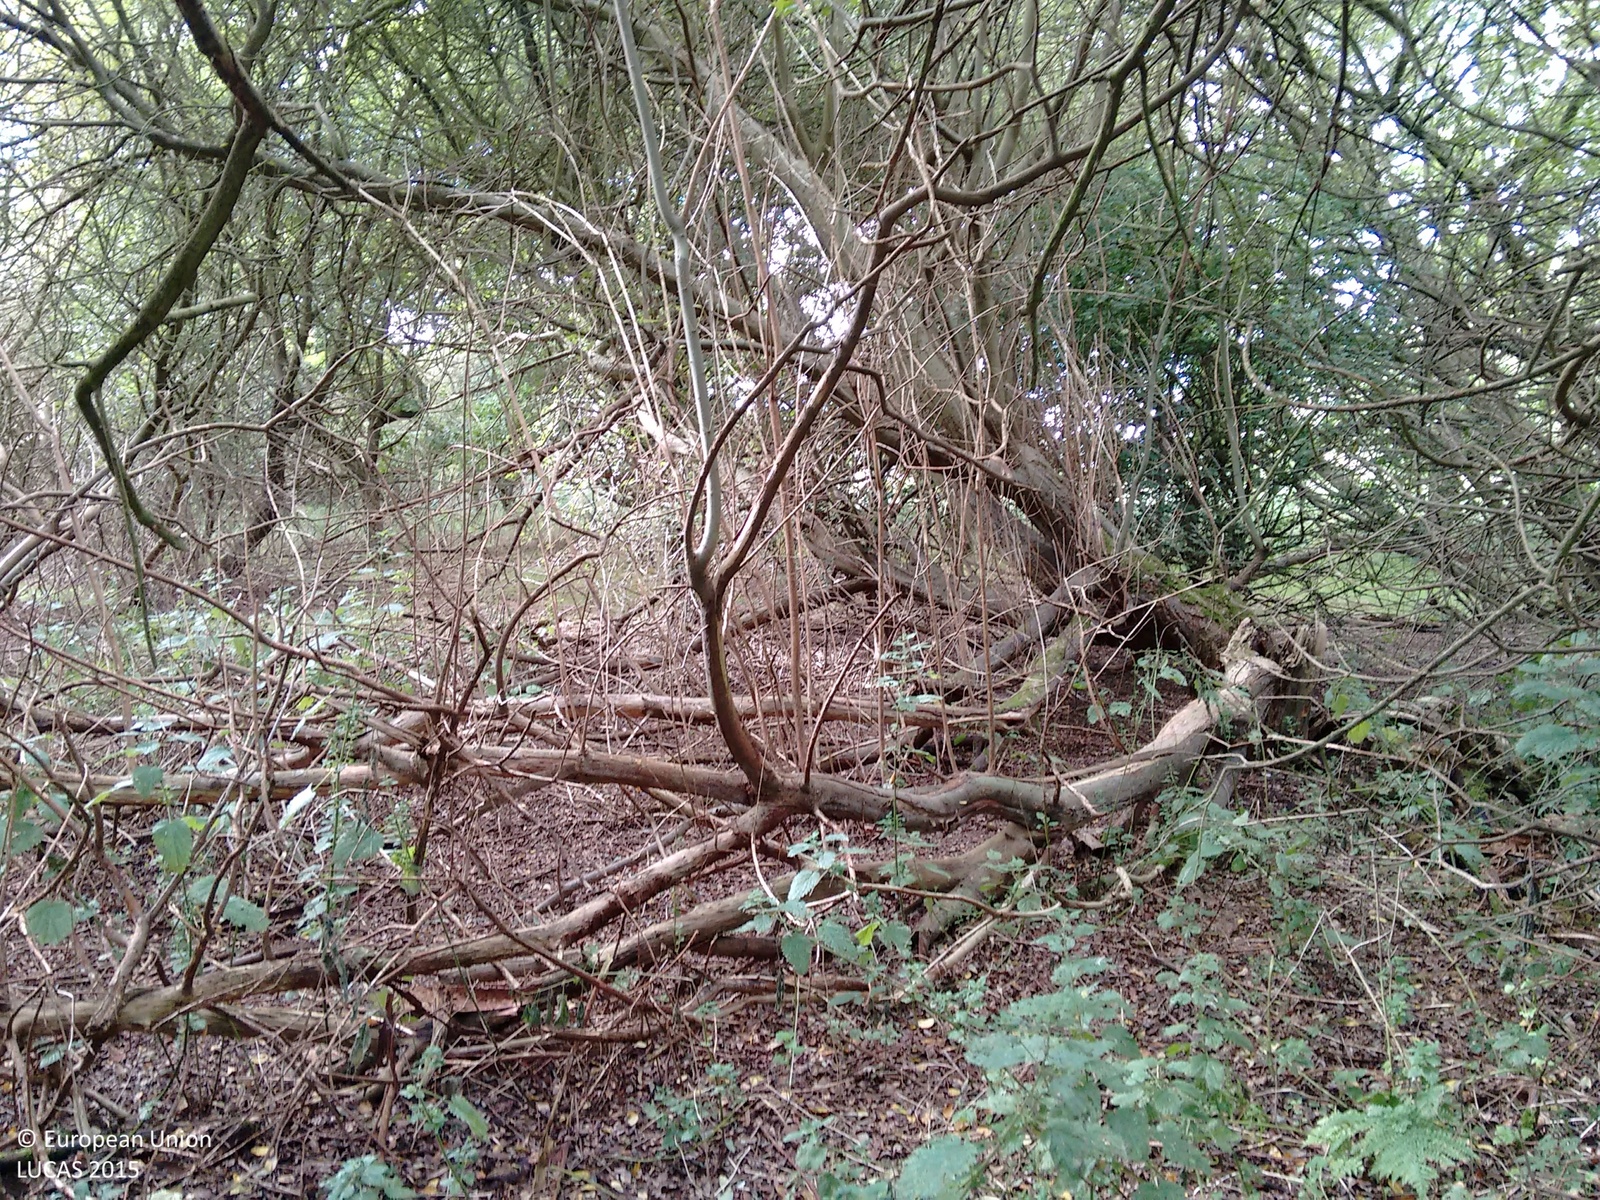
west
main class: Woodland
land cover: Other mixed woodland
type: mesophytic deciduous forest
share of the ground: > 75 %
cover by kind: broadleaved forest trees 75 %, coniferous forest trees 25 %
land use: Forestry
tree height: > 5 m
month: September
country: GB
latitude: 52.7353
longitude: 1.6739
